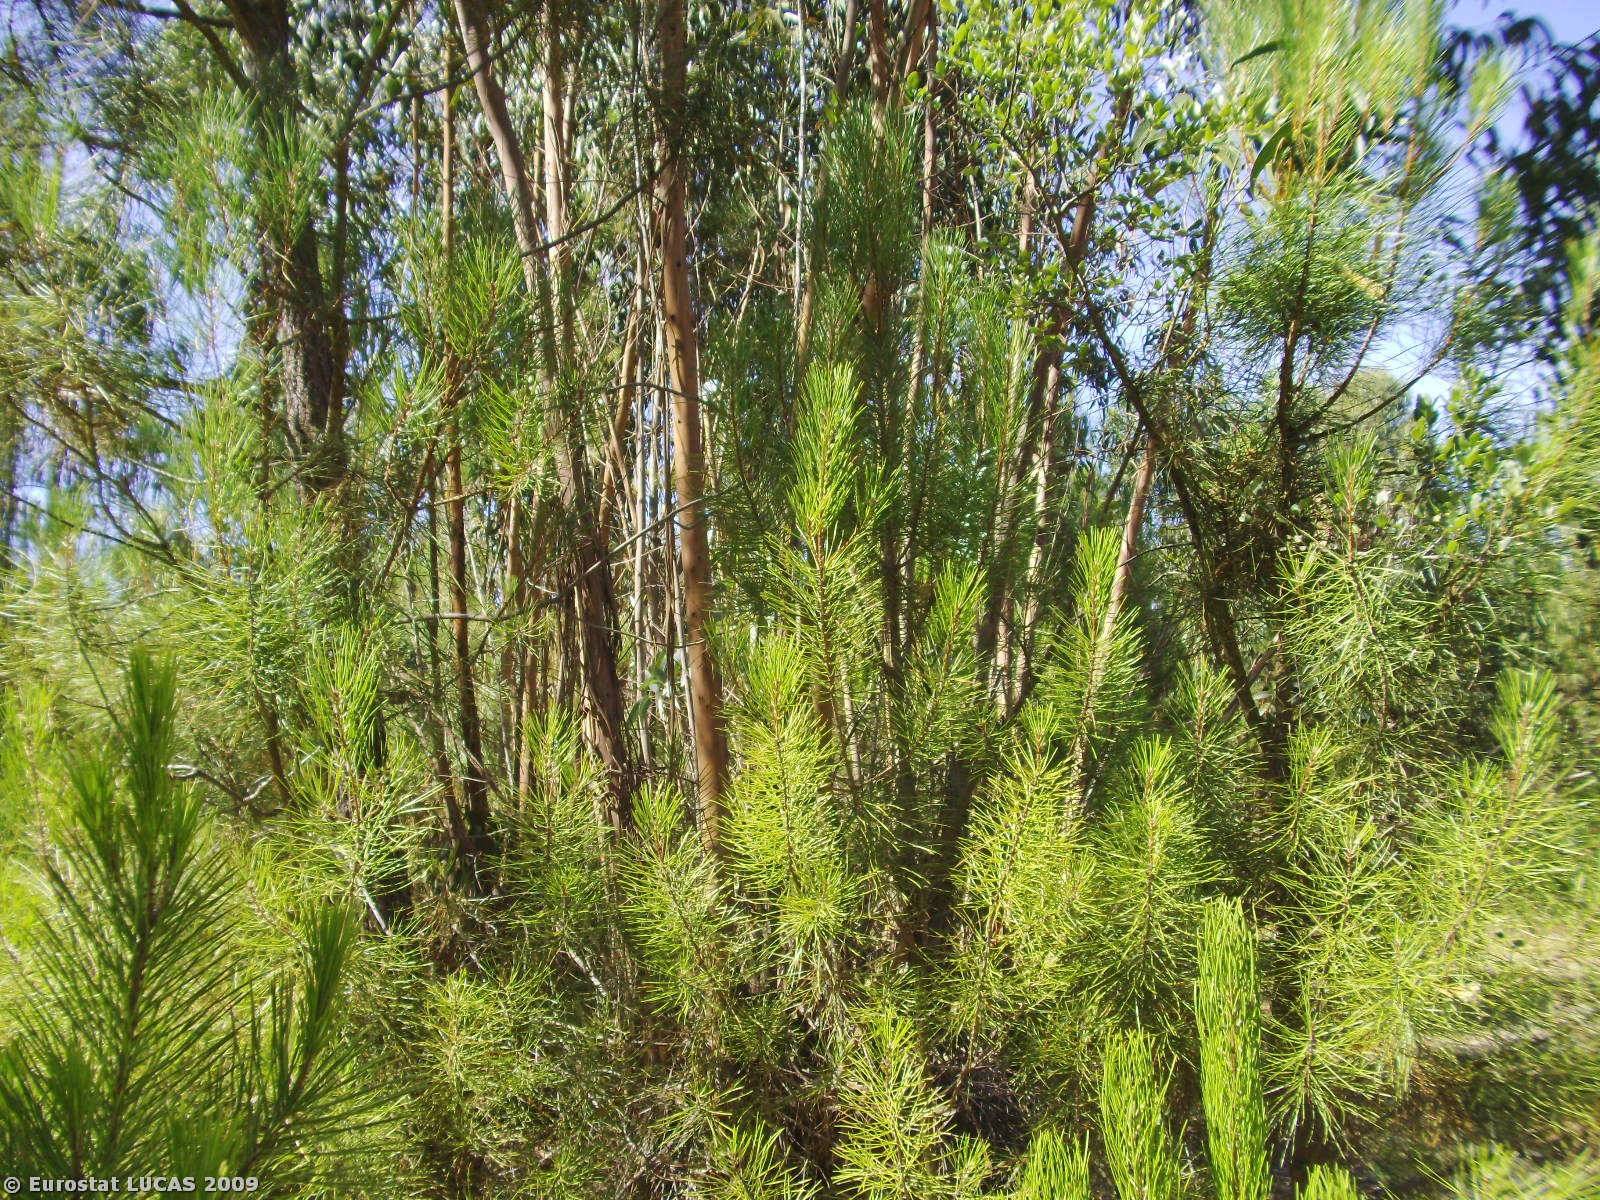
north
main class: Woodland
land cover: Mixed woodland
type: coniferous forest of the mediterranean region
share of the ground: 50 - 75 %
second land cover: Bare land
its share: 25 - 50 %
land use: Forestry
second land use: Fallow land
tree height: > 5 m
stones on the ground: < 10 %
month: August
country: PT
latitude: 38.7271
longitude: -8.7090
